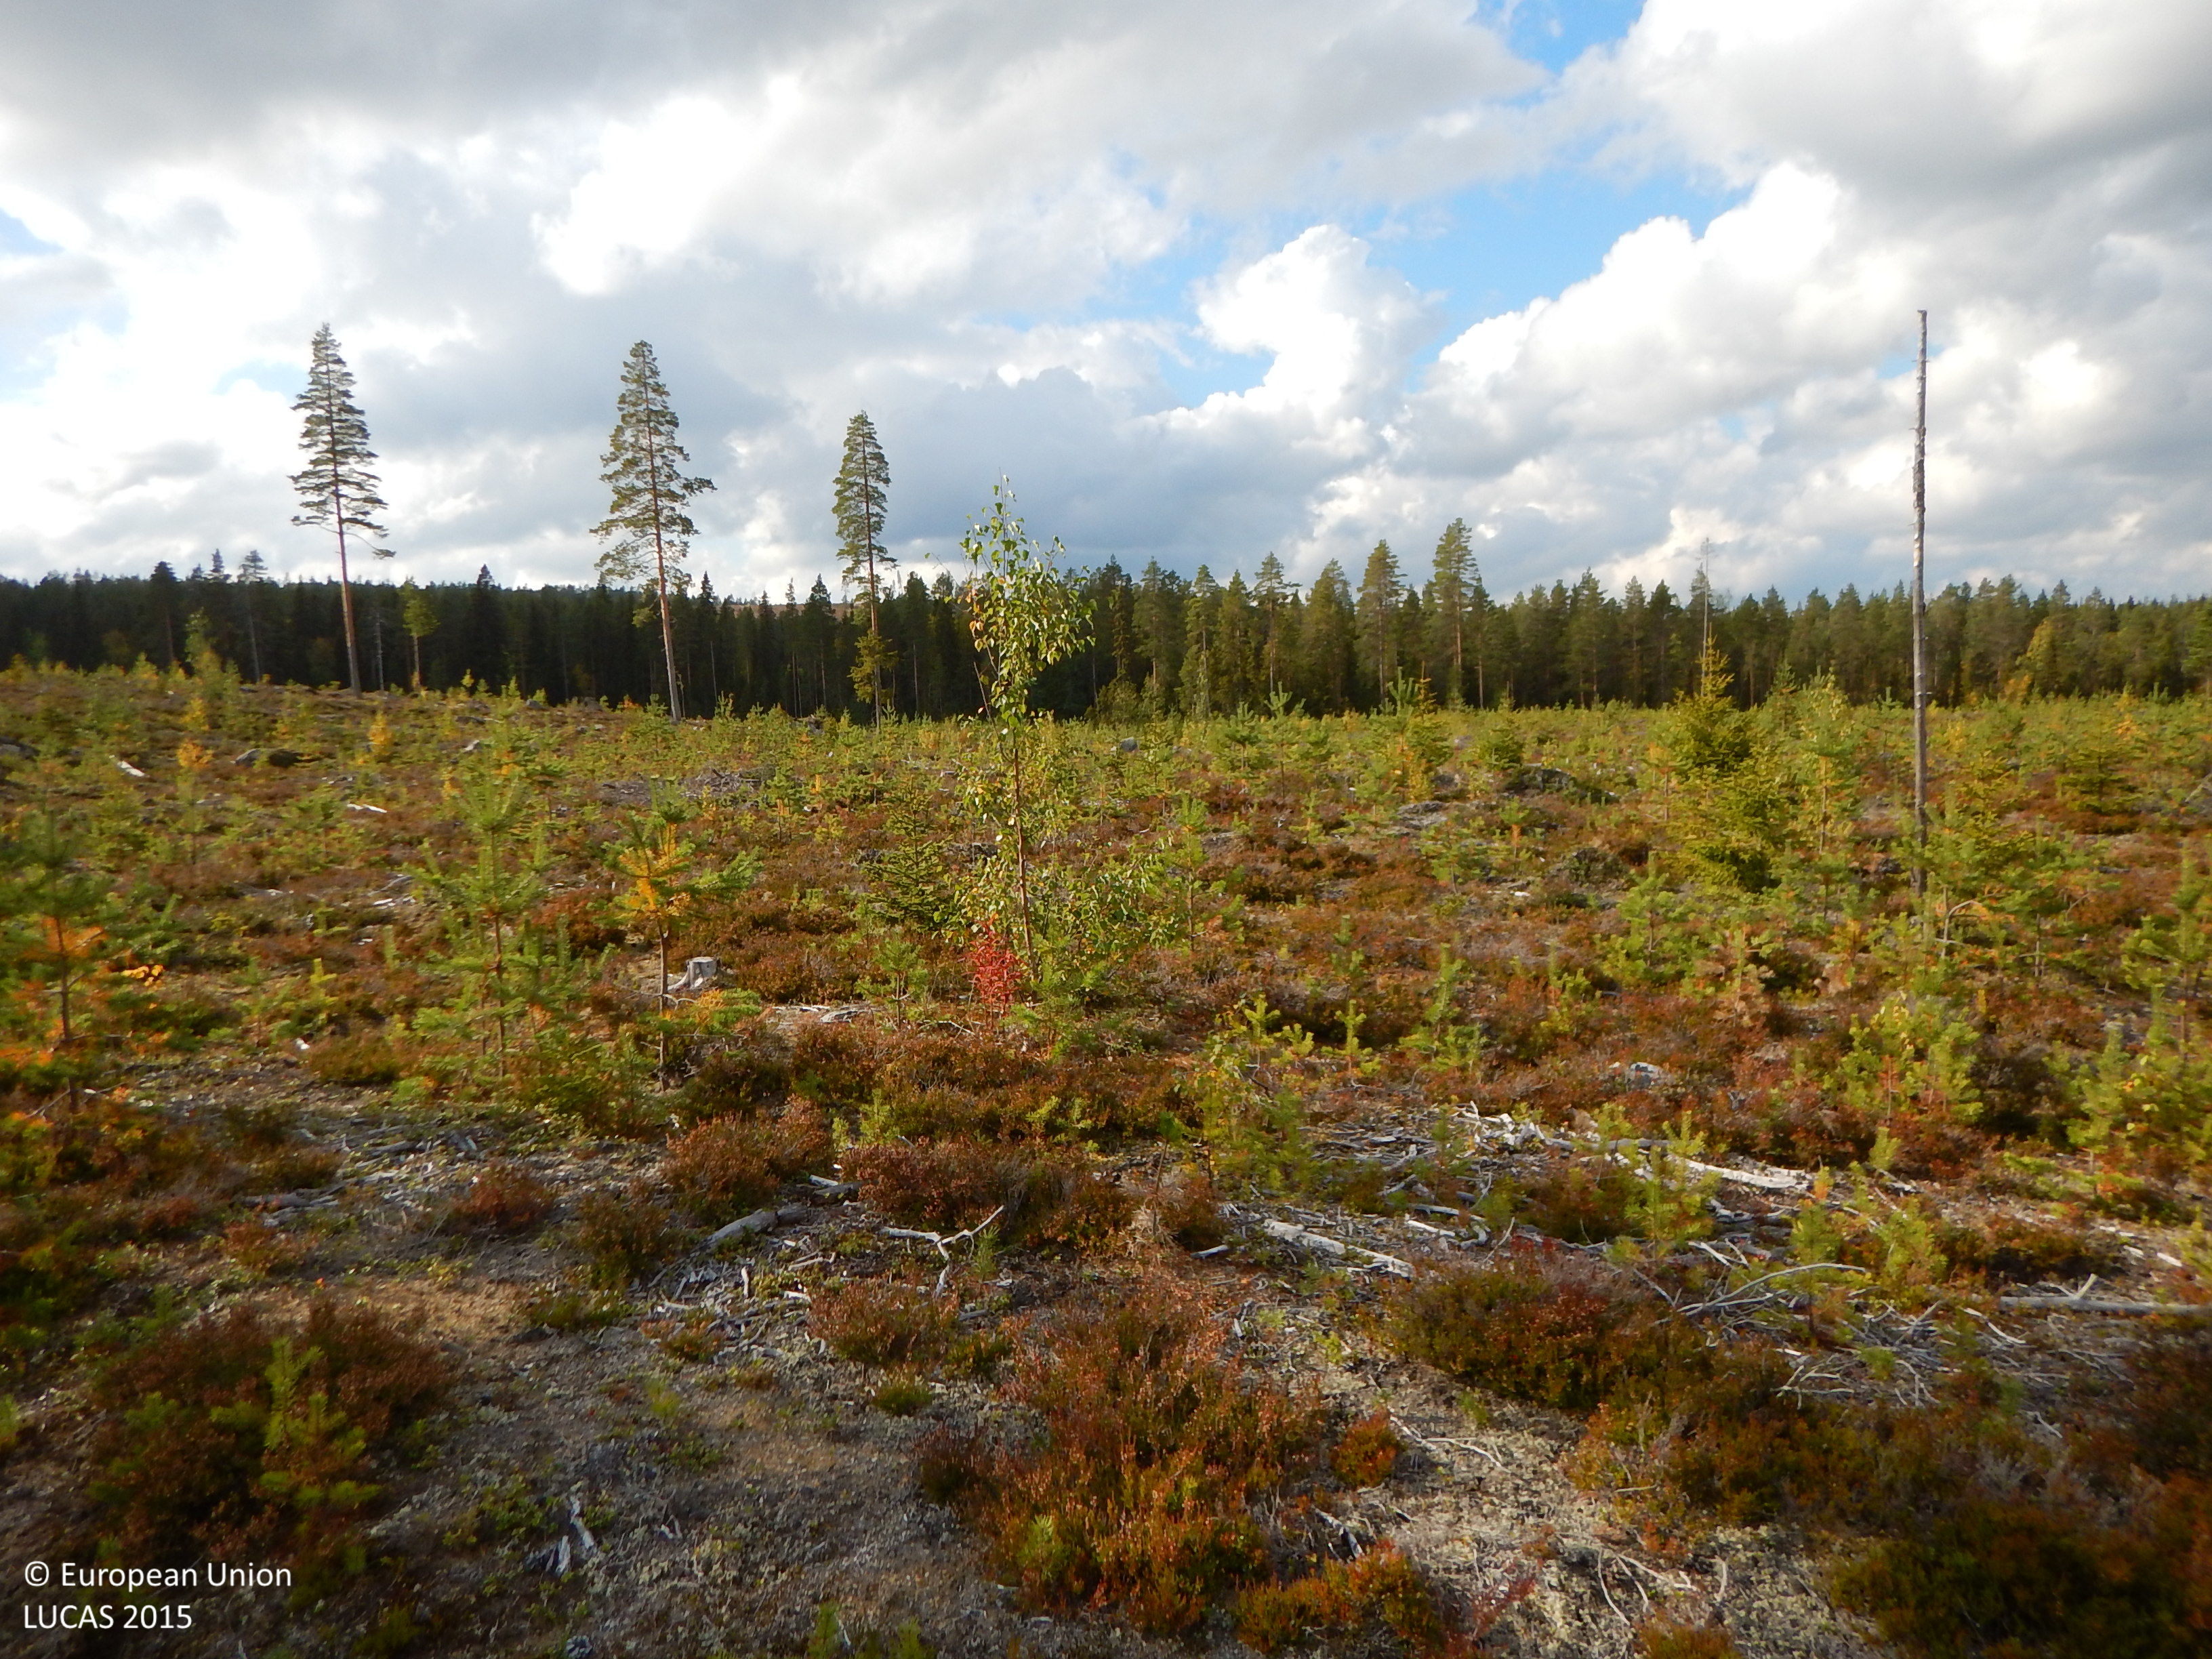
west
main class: Woodland
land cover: Pine dominated coniferous woodland
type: boreal forest
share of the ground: 10 - 25 %
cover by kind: shrubs 30 %, lichens and mosses 25 %, herbaceous plants 20 %, unconsolidated bare surface 15 %, coniferous forest trees 10 %
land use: Forestry
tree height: < 5 m
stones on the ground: < 10 %
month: September
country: SE
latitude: 64.8203
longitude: 20.1464
